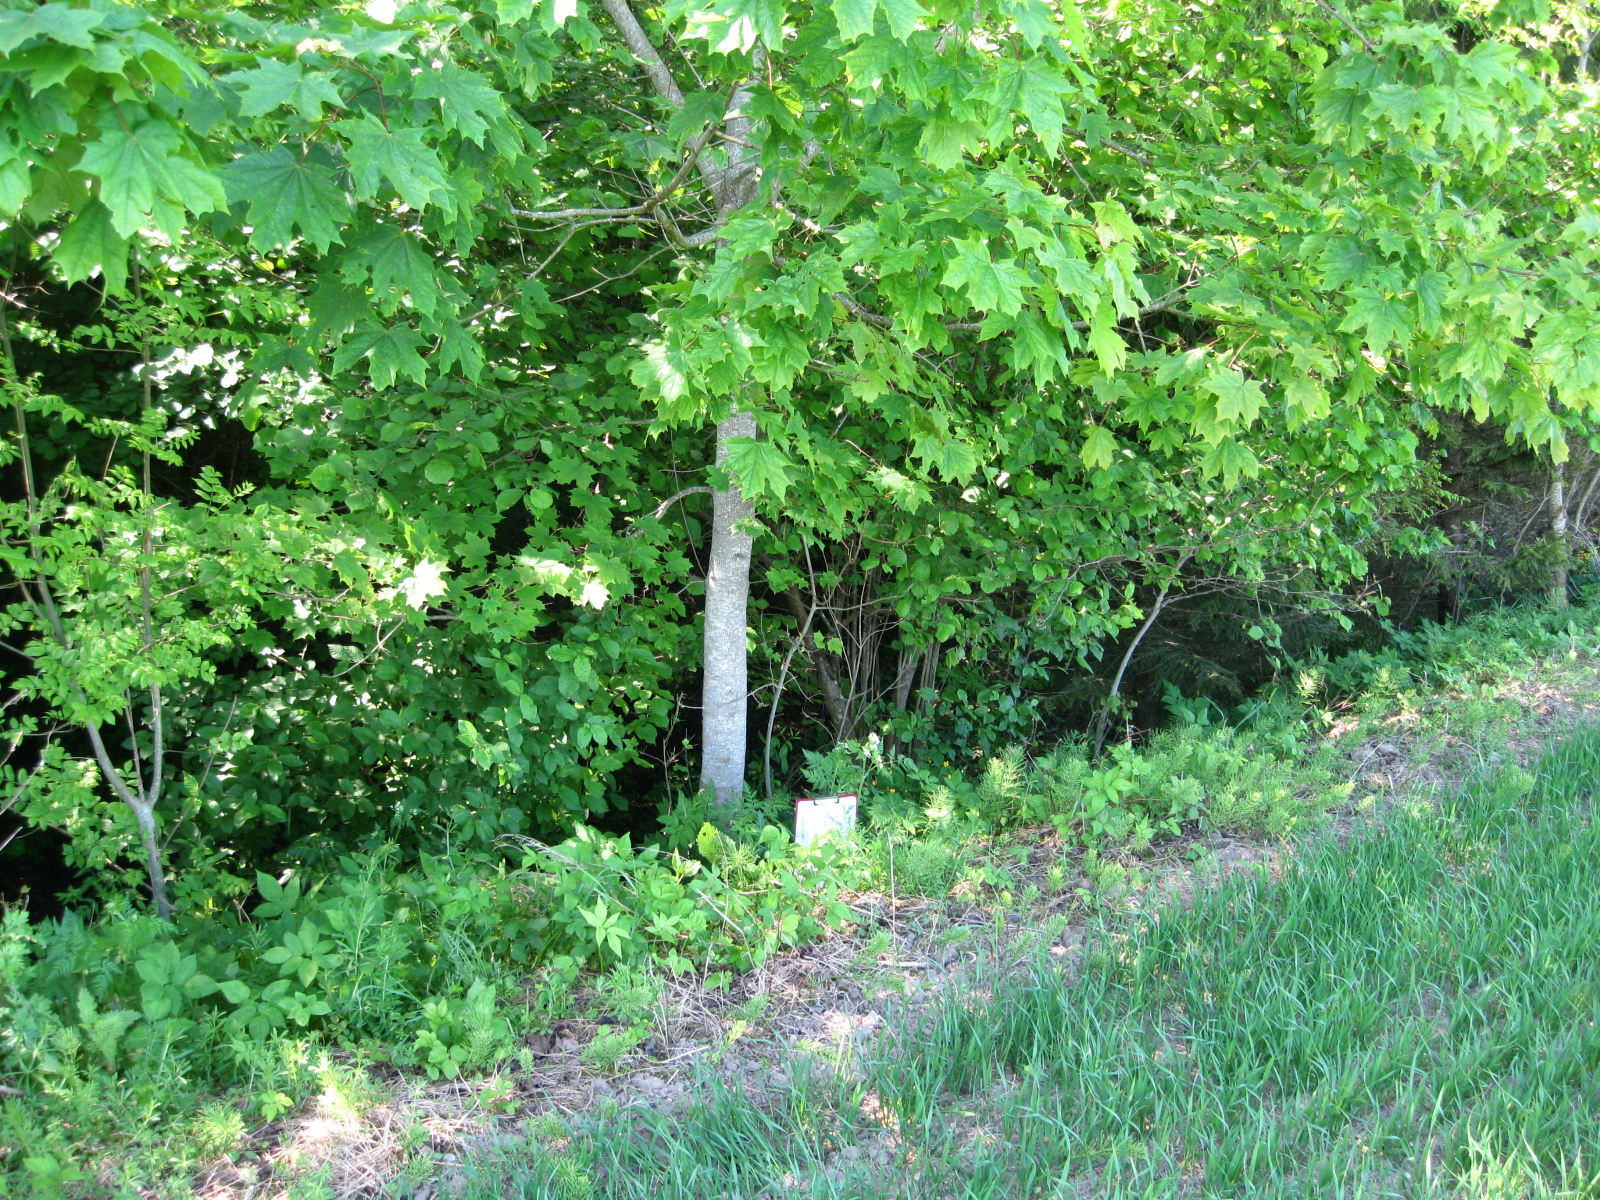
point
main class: Woodland
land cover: Broadleaved woodland
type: non-riverine alder, birch or aspen forest
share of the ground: > 75 %
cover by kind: broadleaved forest trees 80 %, coniferous forest trees 10 %, herbaceous plants 10 %
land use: Forestry
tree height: > 5 m
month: June
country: LT
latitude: 55.9198
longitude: 23.7314
